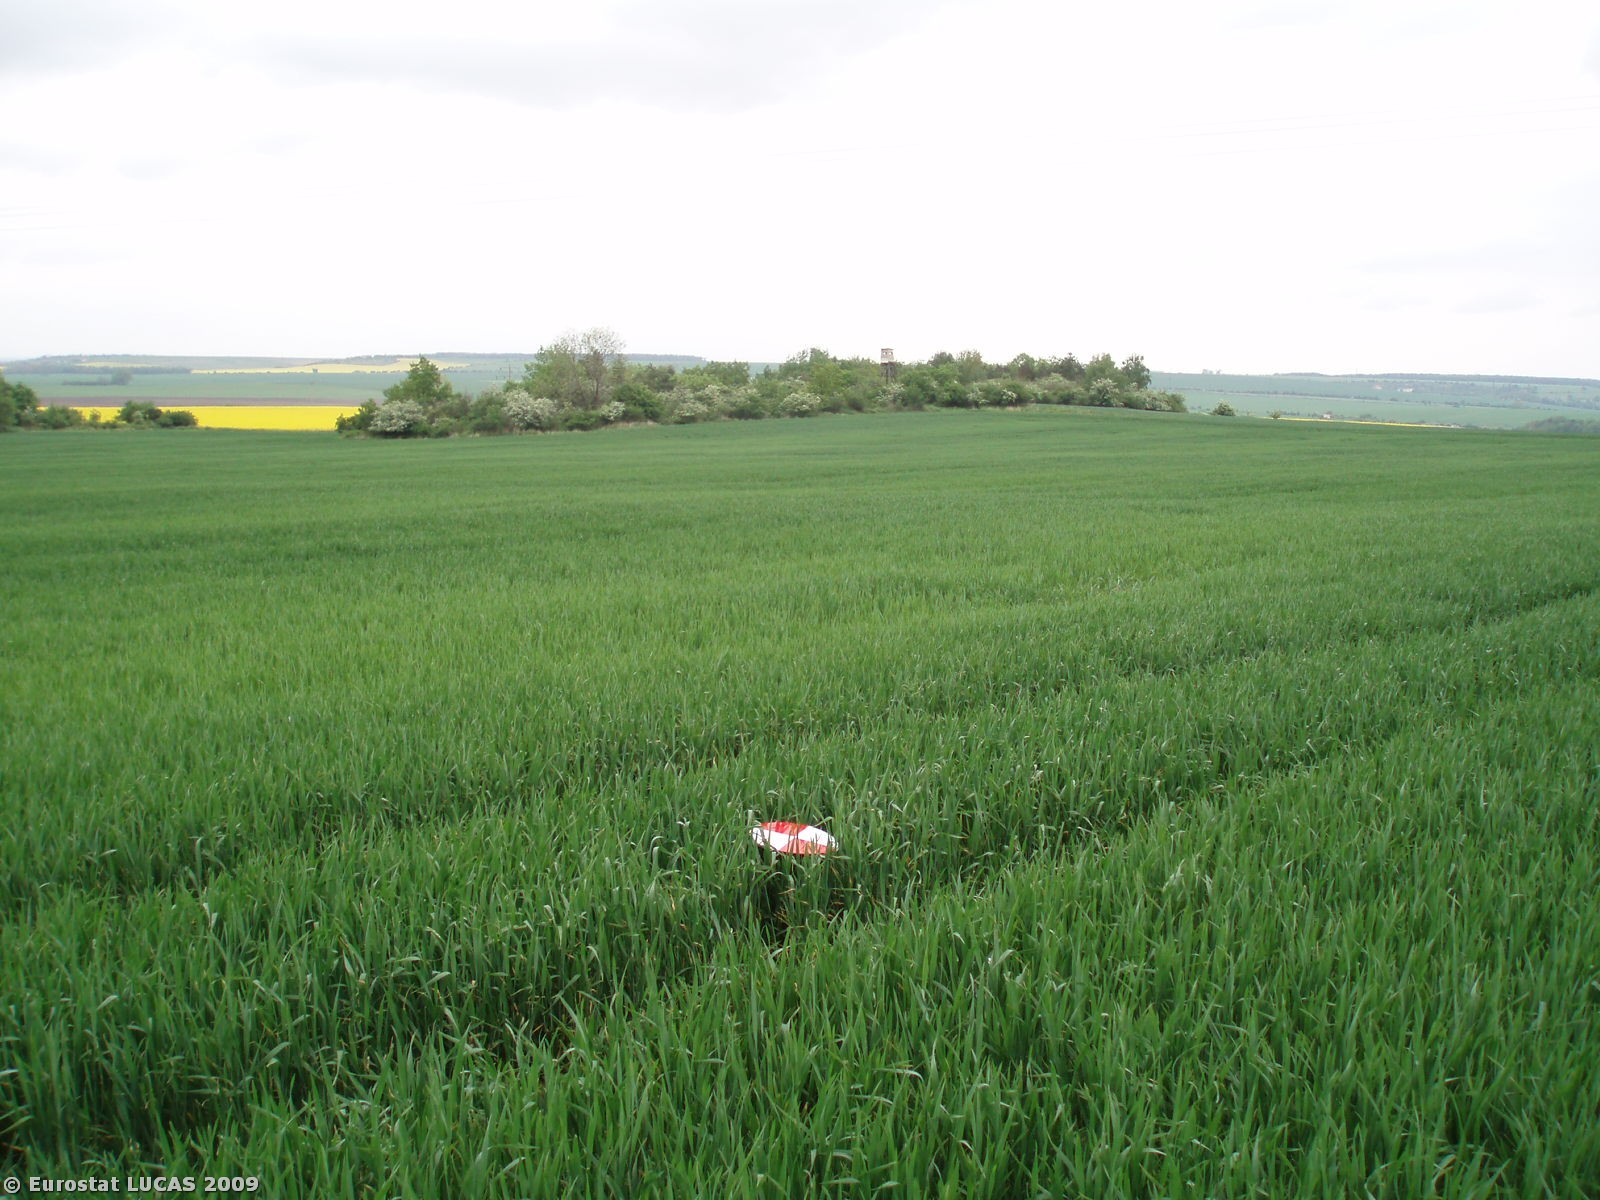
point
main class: Cropland
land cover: Common wheat
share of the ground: > 75 %
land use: Agriculture (excluding fallow land and kitchen gardens)
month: May
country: CZ
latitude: 50.2322
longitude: 14.2210
